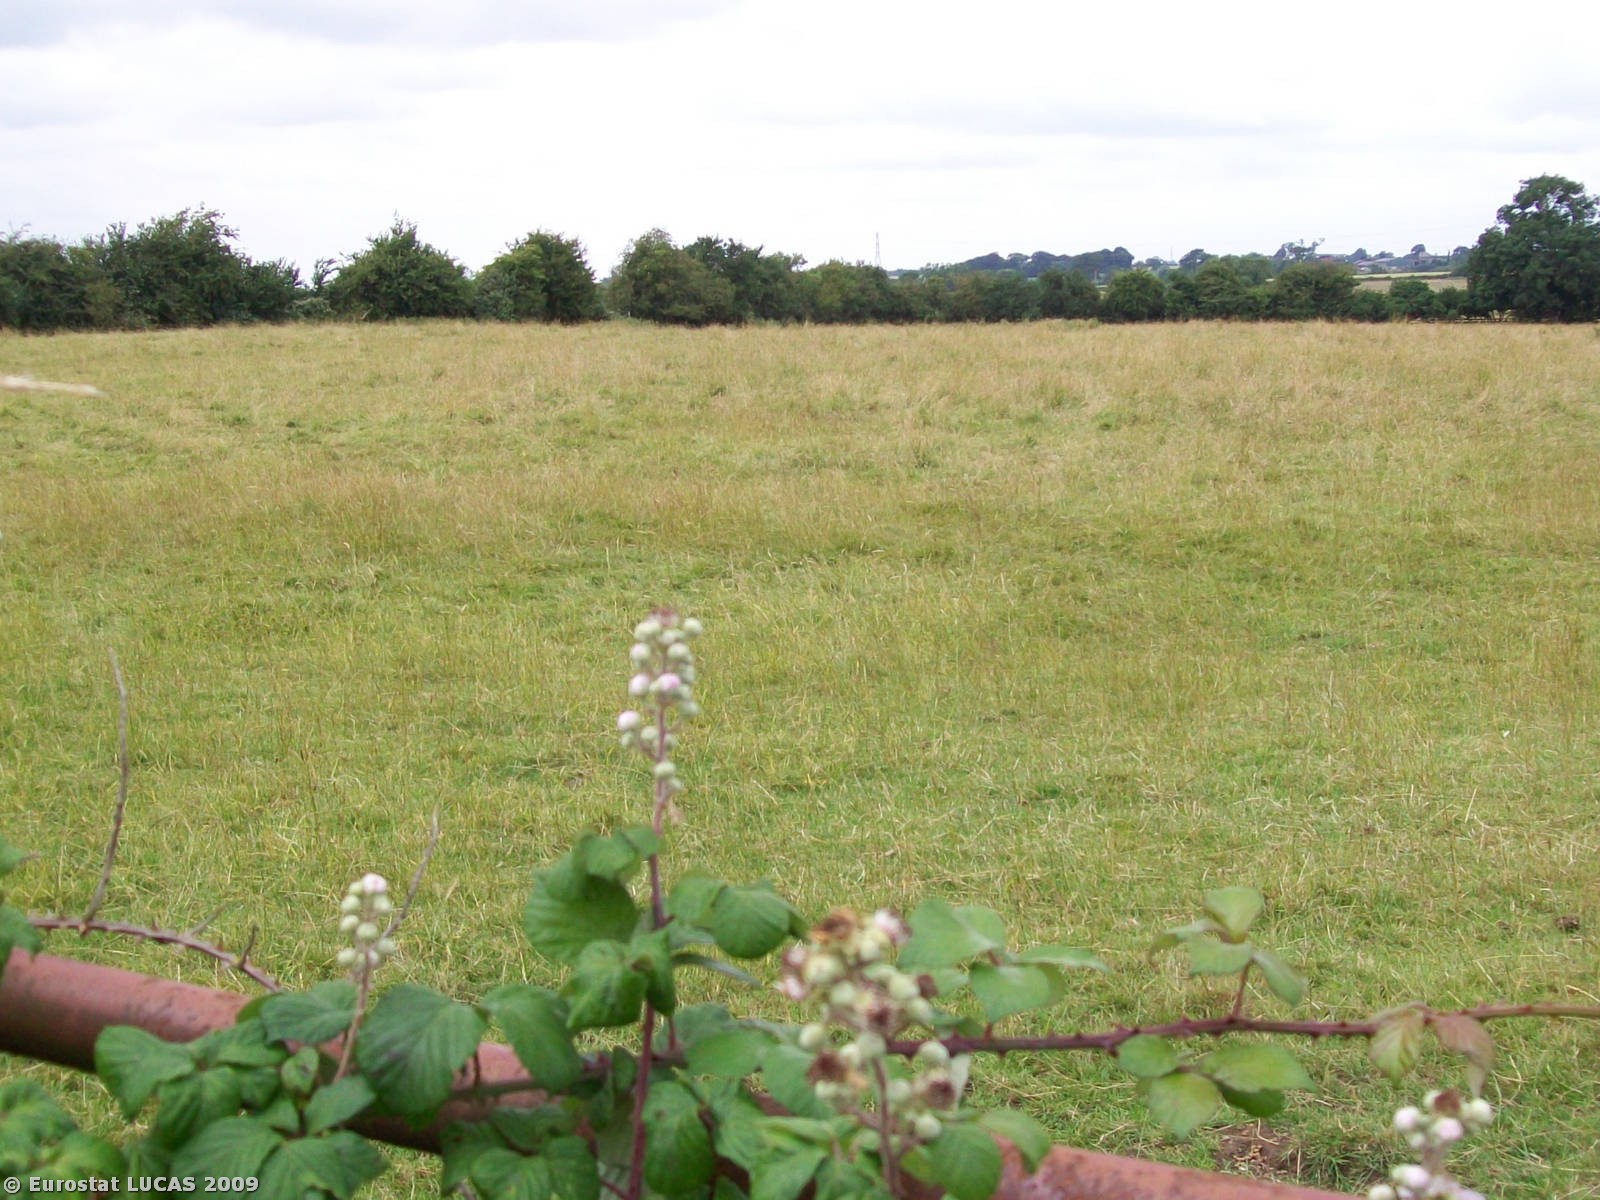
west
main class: Grassland
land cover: Grassland without tree/shrub cover
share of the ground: > 75 %
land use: Agriculture (excluding fallow land and kitchen gardens)
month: July
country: GB
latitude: 51.9659
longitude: -0.8863
